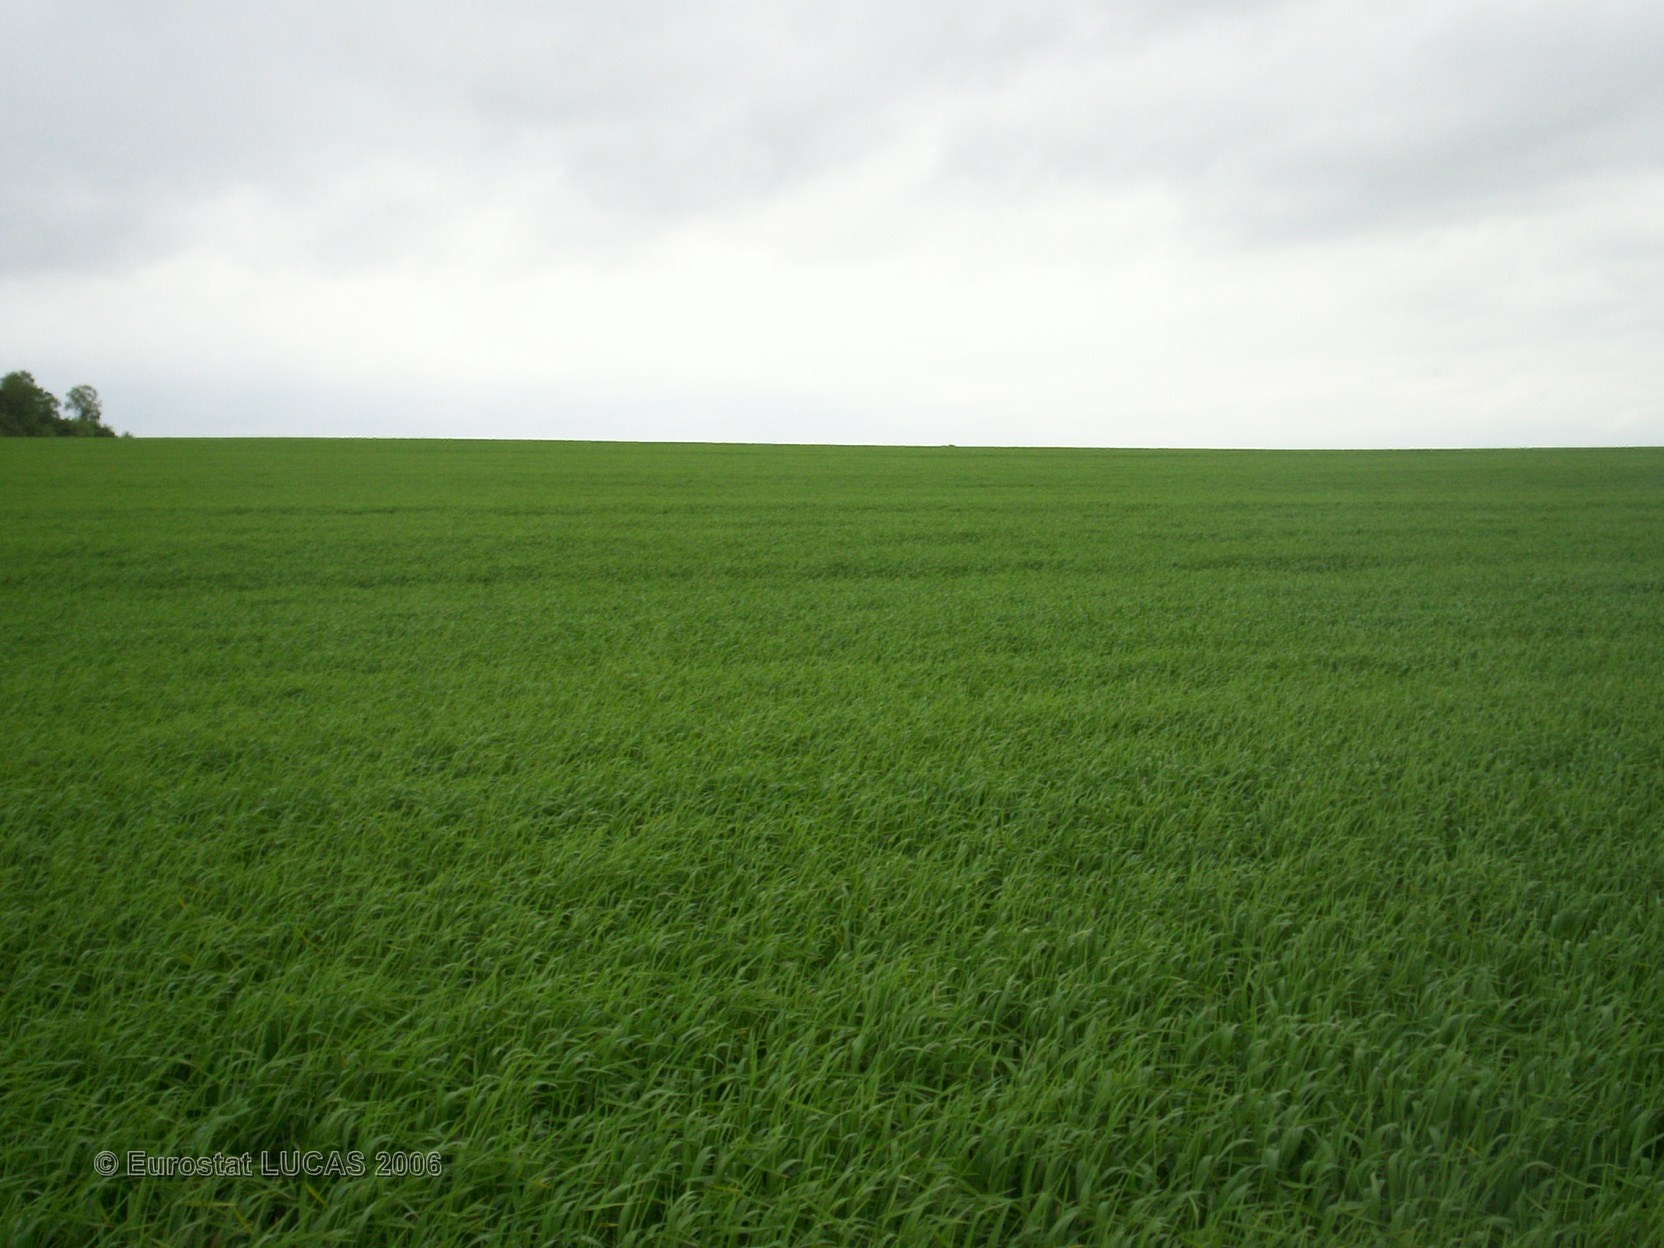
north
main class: Cropland
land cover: Barley
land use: Agriculture (excluding fallow land and kitchen gardens)
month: May
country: FR
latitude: 49.3240
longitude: 4.3688
